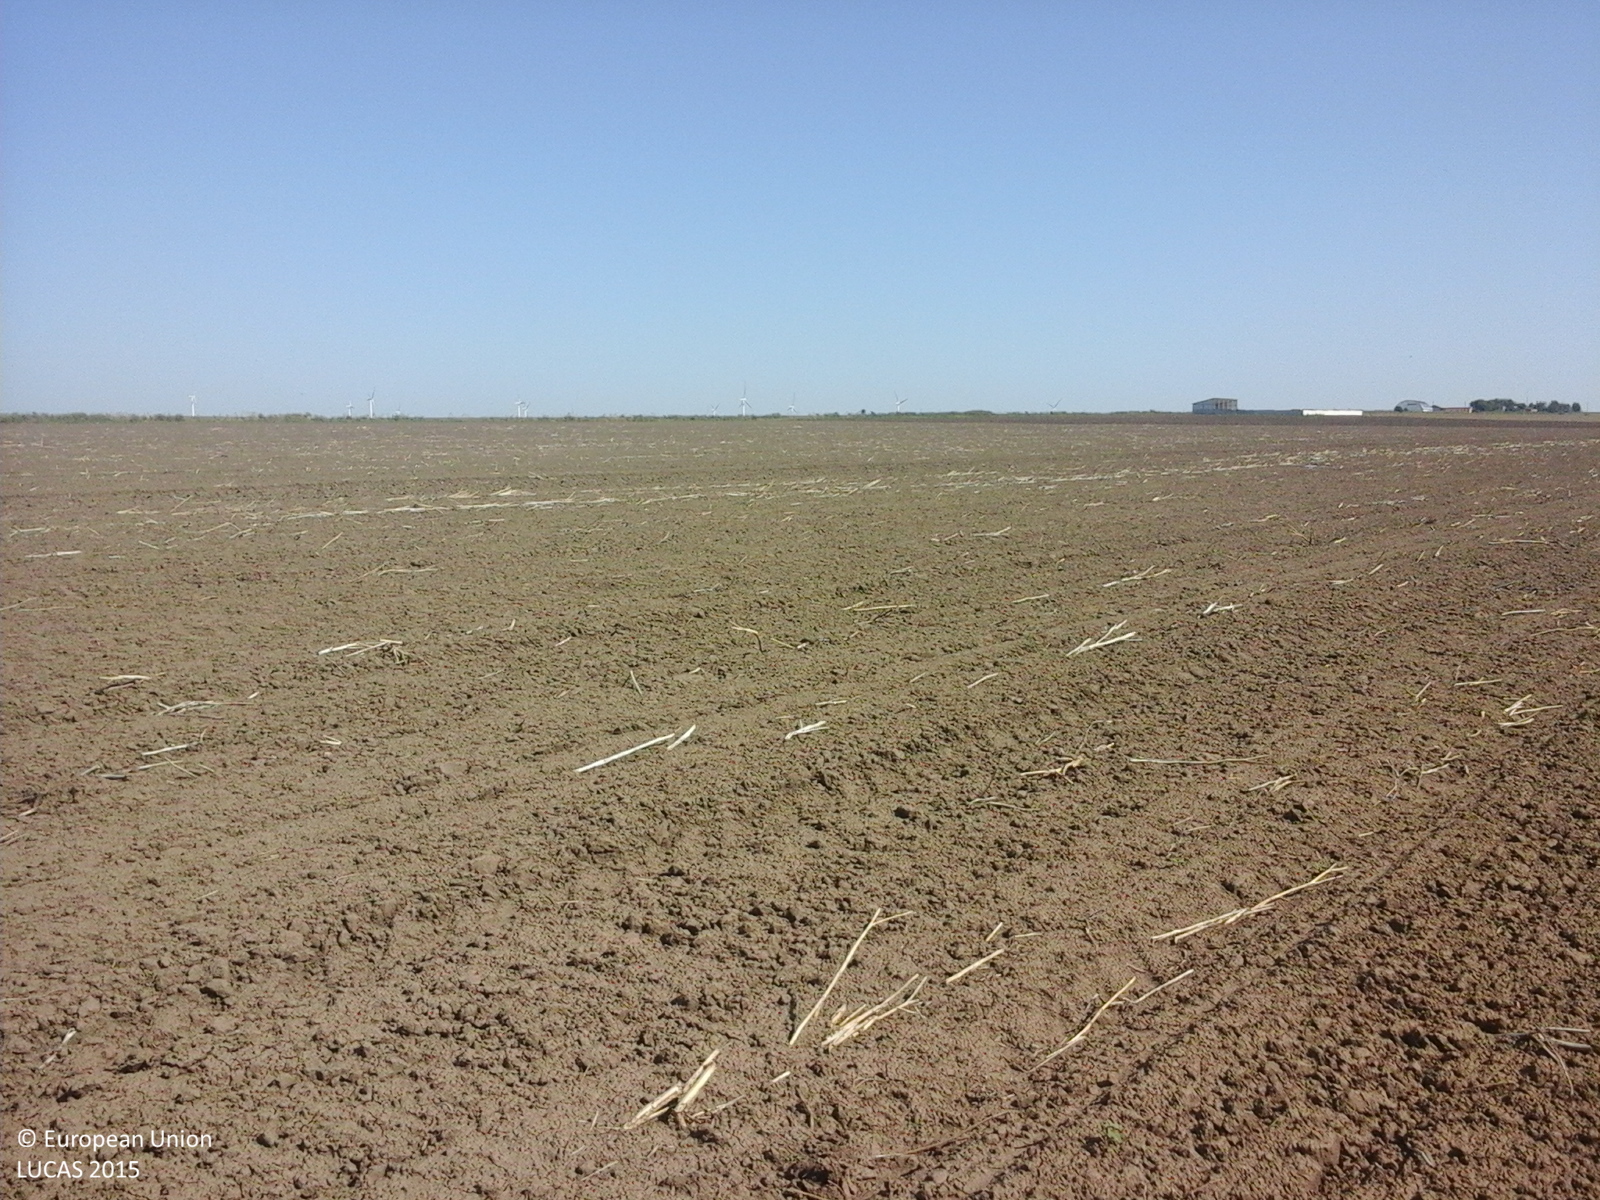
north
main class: Cropland
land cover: Rape and turnip rape
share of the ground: < 10 %
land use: Agriculture (excluding fallow land and kitchen gardens)
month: August
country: RO
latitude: 44.3151
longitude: 28.3846
